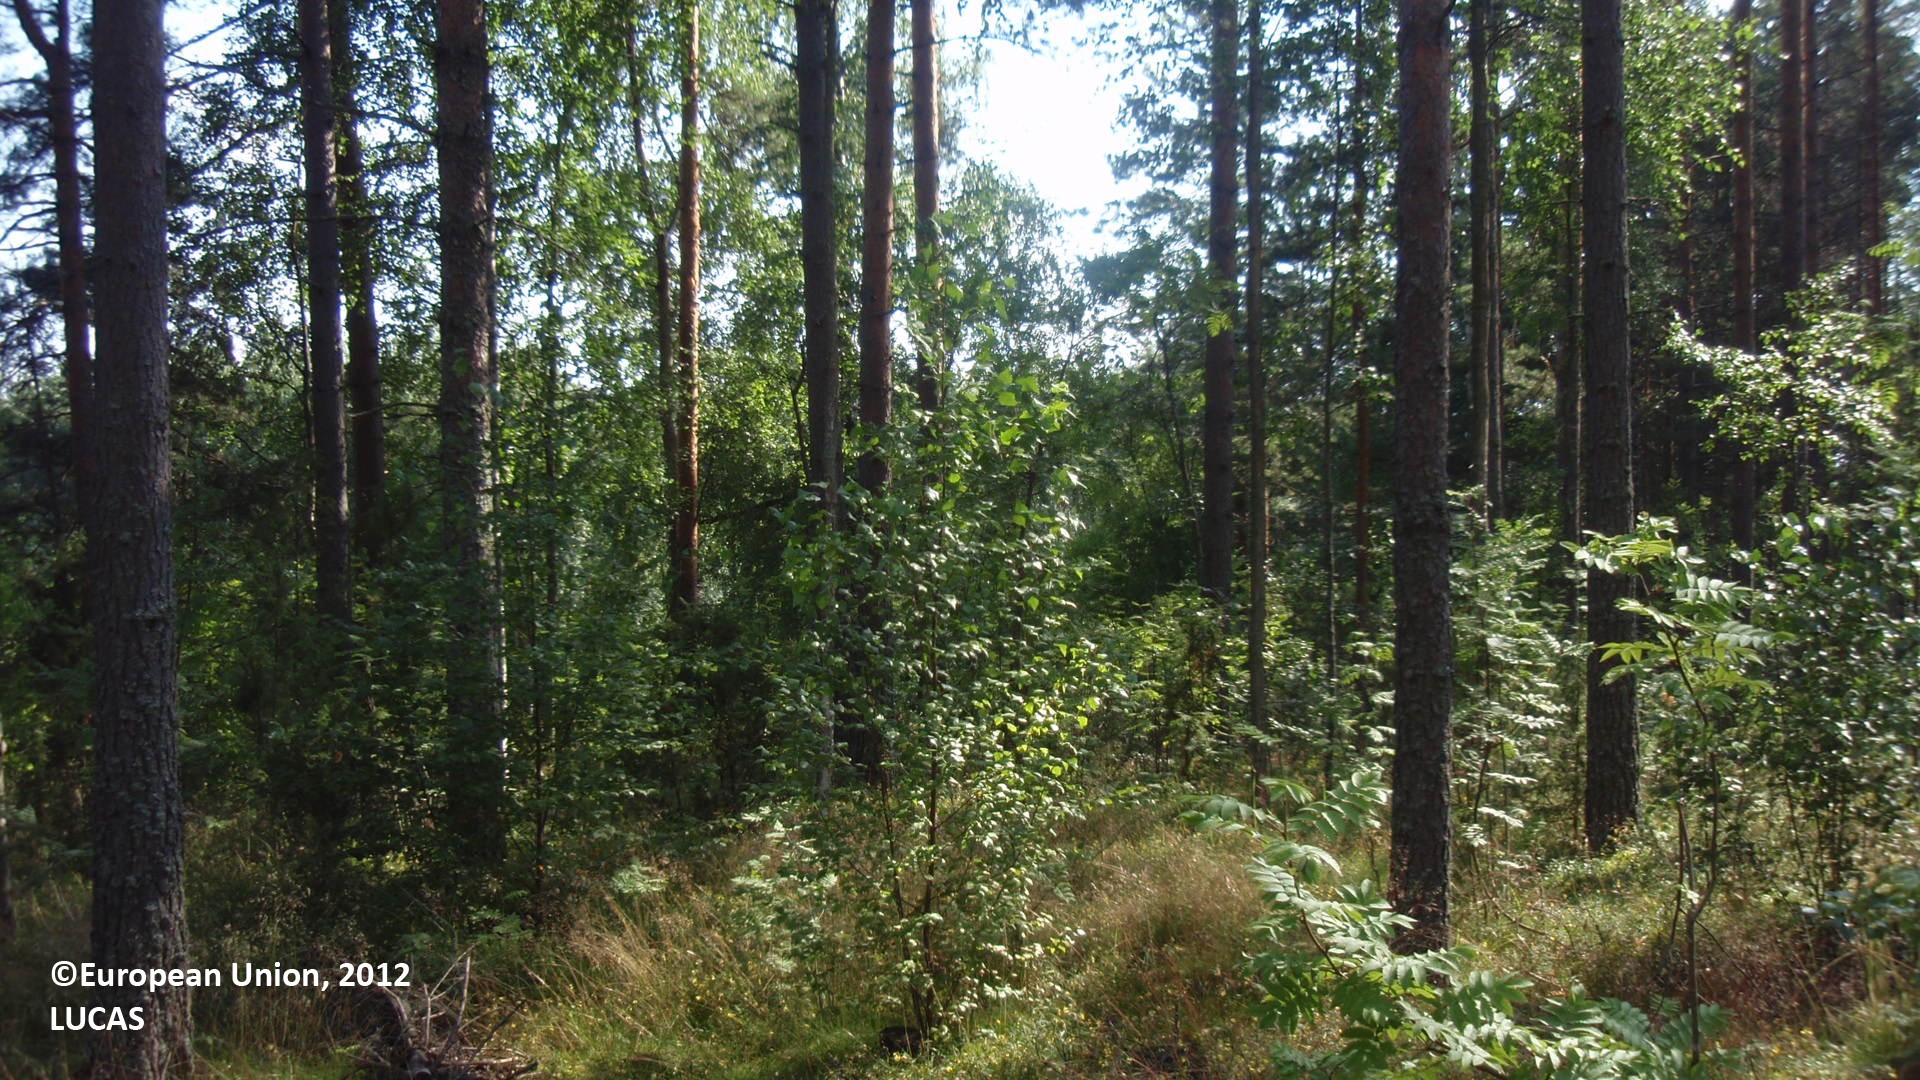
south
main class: Woodland
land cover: Pine dominated coniferous woodland
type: boreal forest
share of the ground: 50 - 75 %
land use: Forestry
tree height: > 5 m
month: July
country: FI
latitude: 61.3982
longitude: 28.3139
